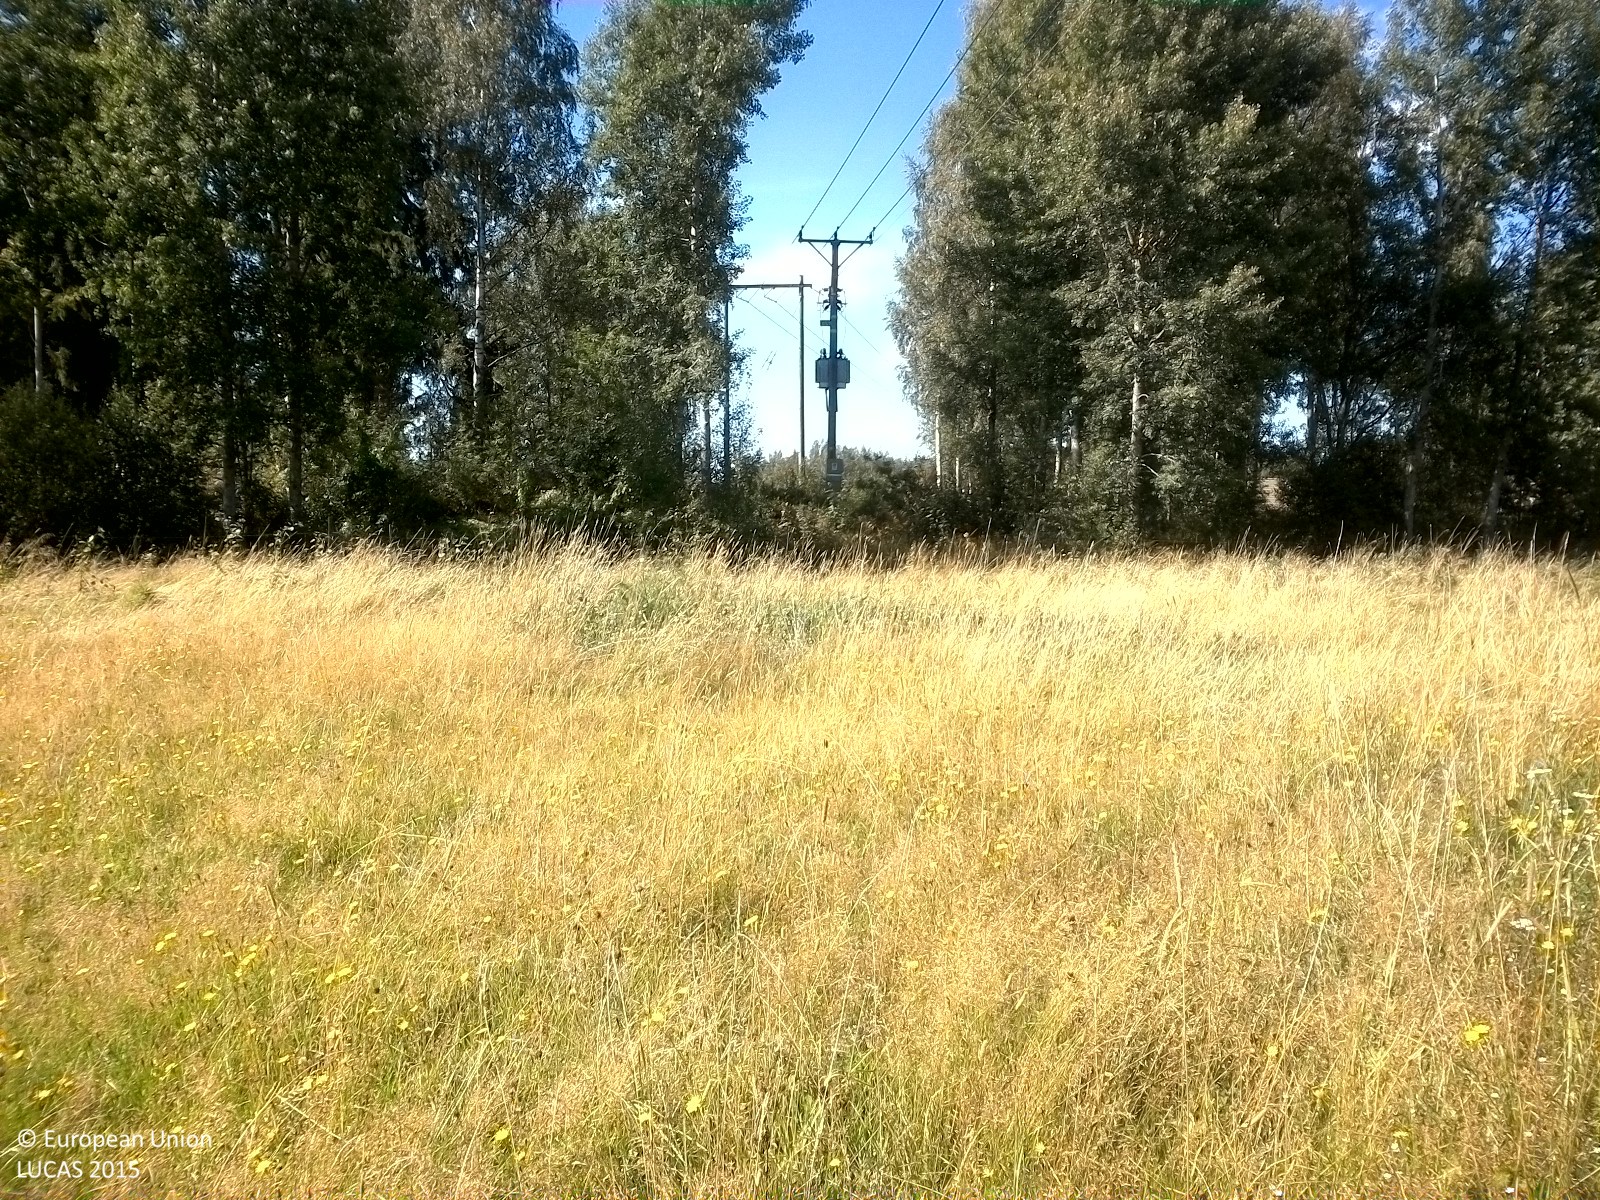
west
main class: Grassland
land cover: Grassland without tree/shrub cover
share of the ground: > 75 %
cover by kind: herbaceous plants 100 %
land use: Agriculture (excluding fallow land and kitchen gardens)
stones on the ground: 10 - 25 %
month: August
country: SE
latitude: 59.4164
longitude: 15.2246
